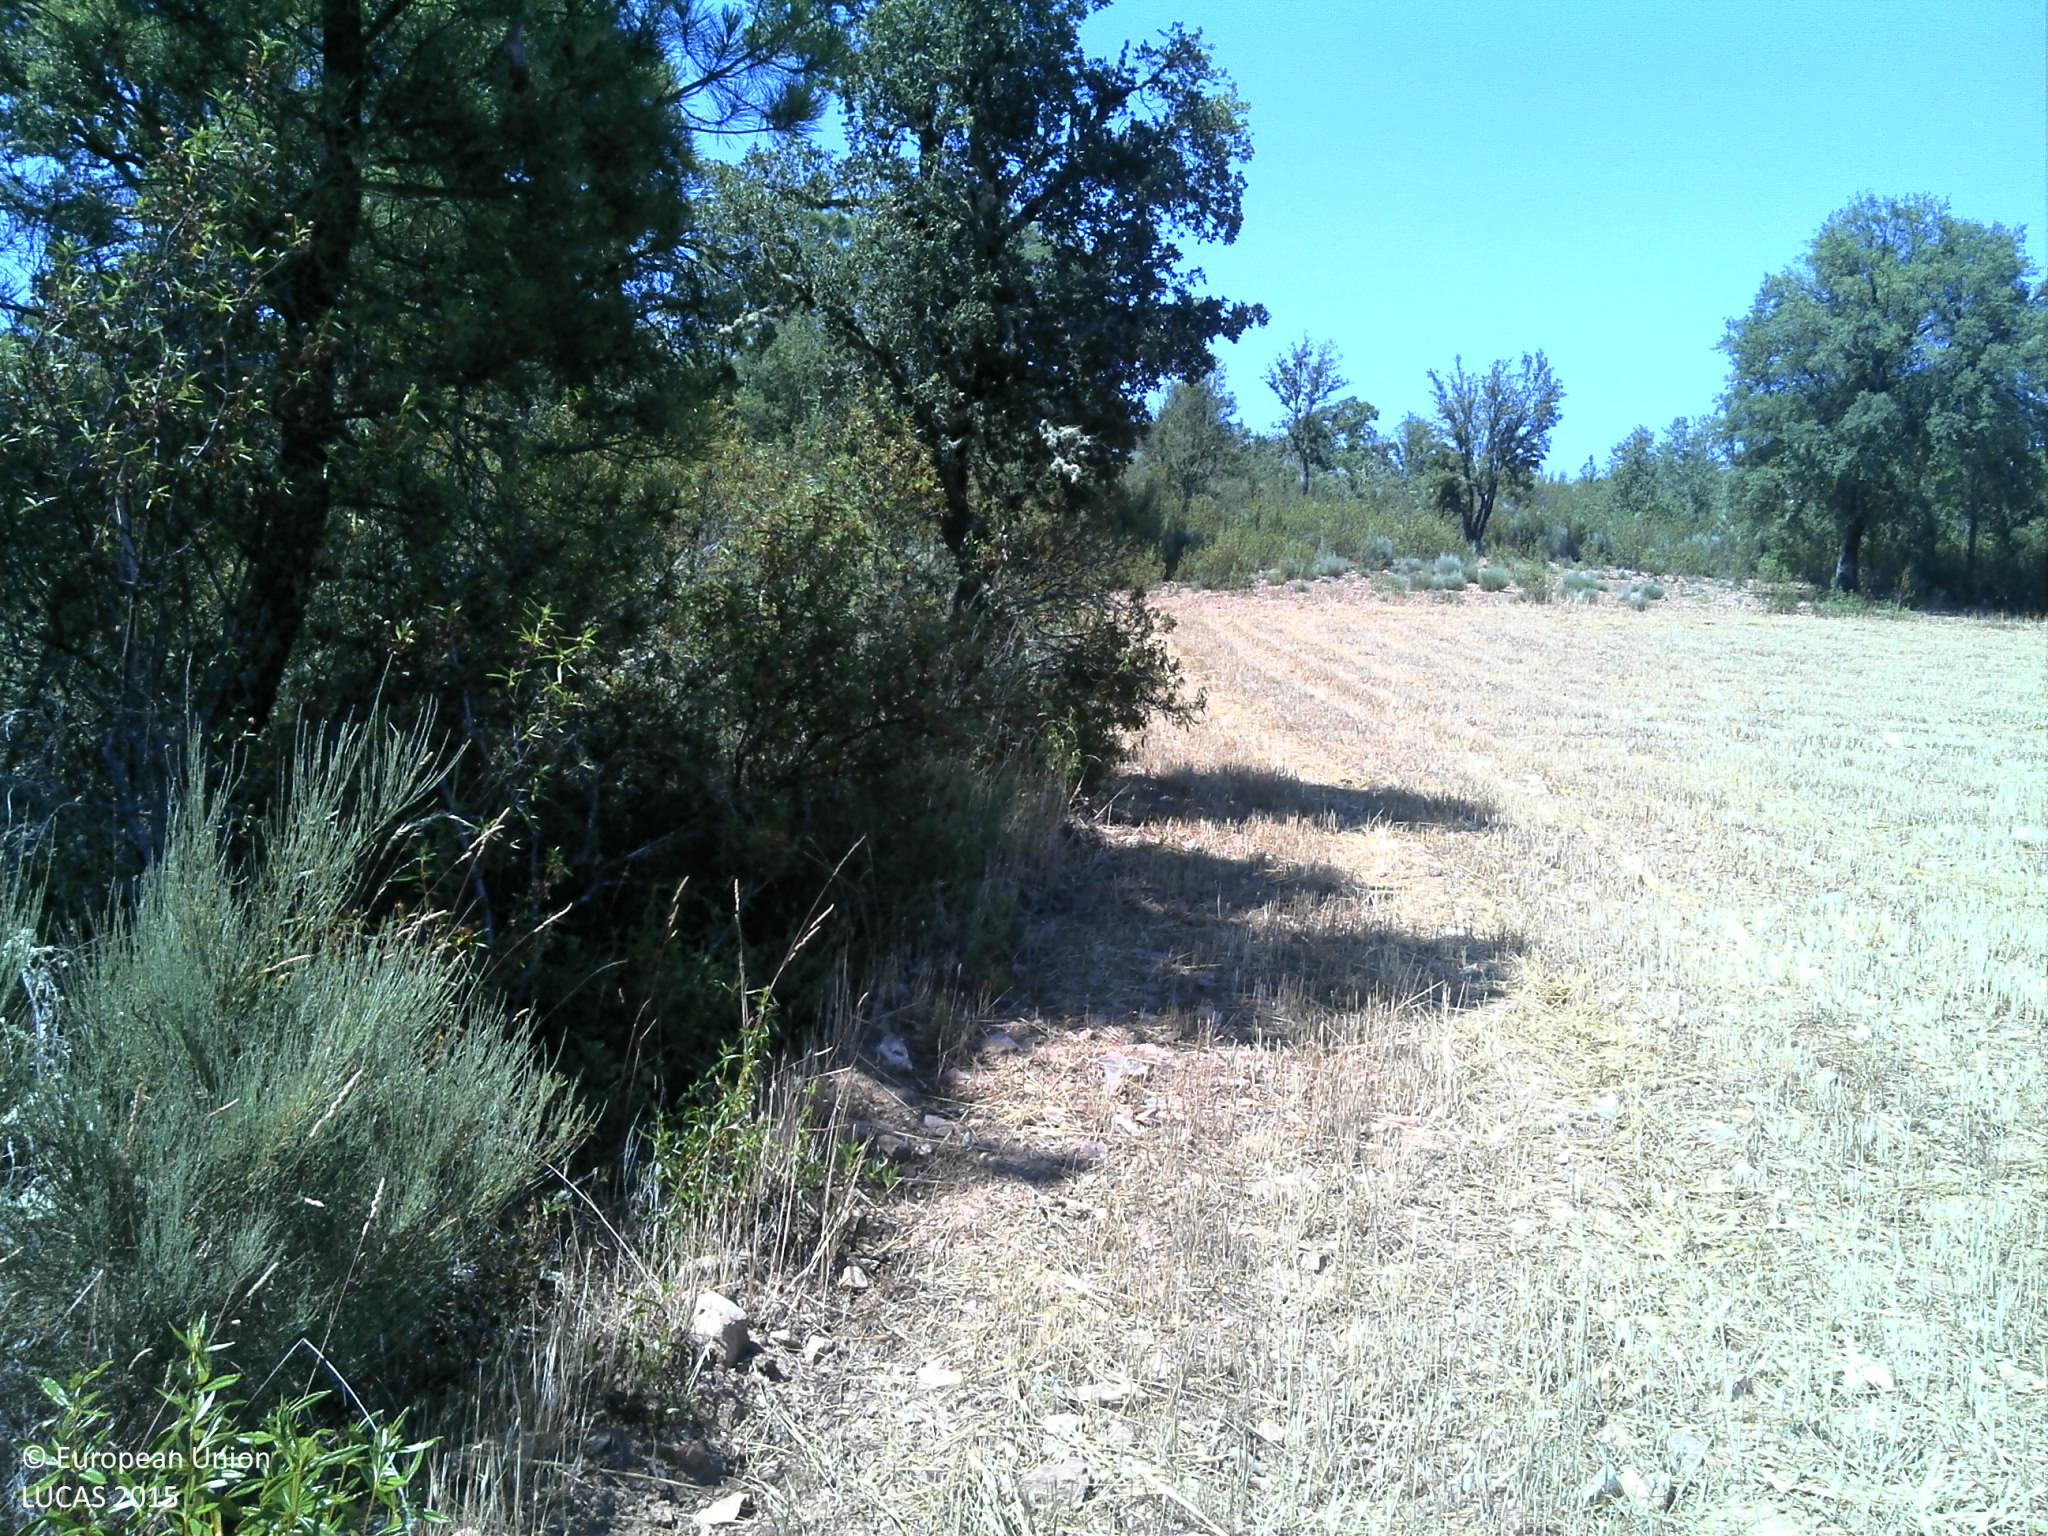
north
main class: Shrubland
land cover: Shrubland with sparse tree cover
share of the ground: > 75 %
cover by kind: shrubs 90 %, coniferous forest trees 5 %, unconsolidated bare surface 5 %
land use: Semi-natural and natural areas not in use
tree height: > 5 m
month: June
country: PT
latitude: 40.8246
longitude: -7.1706
